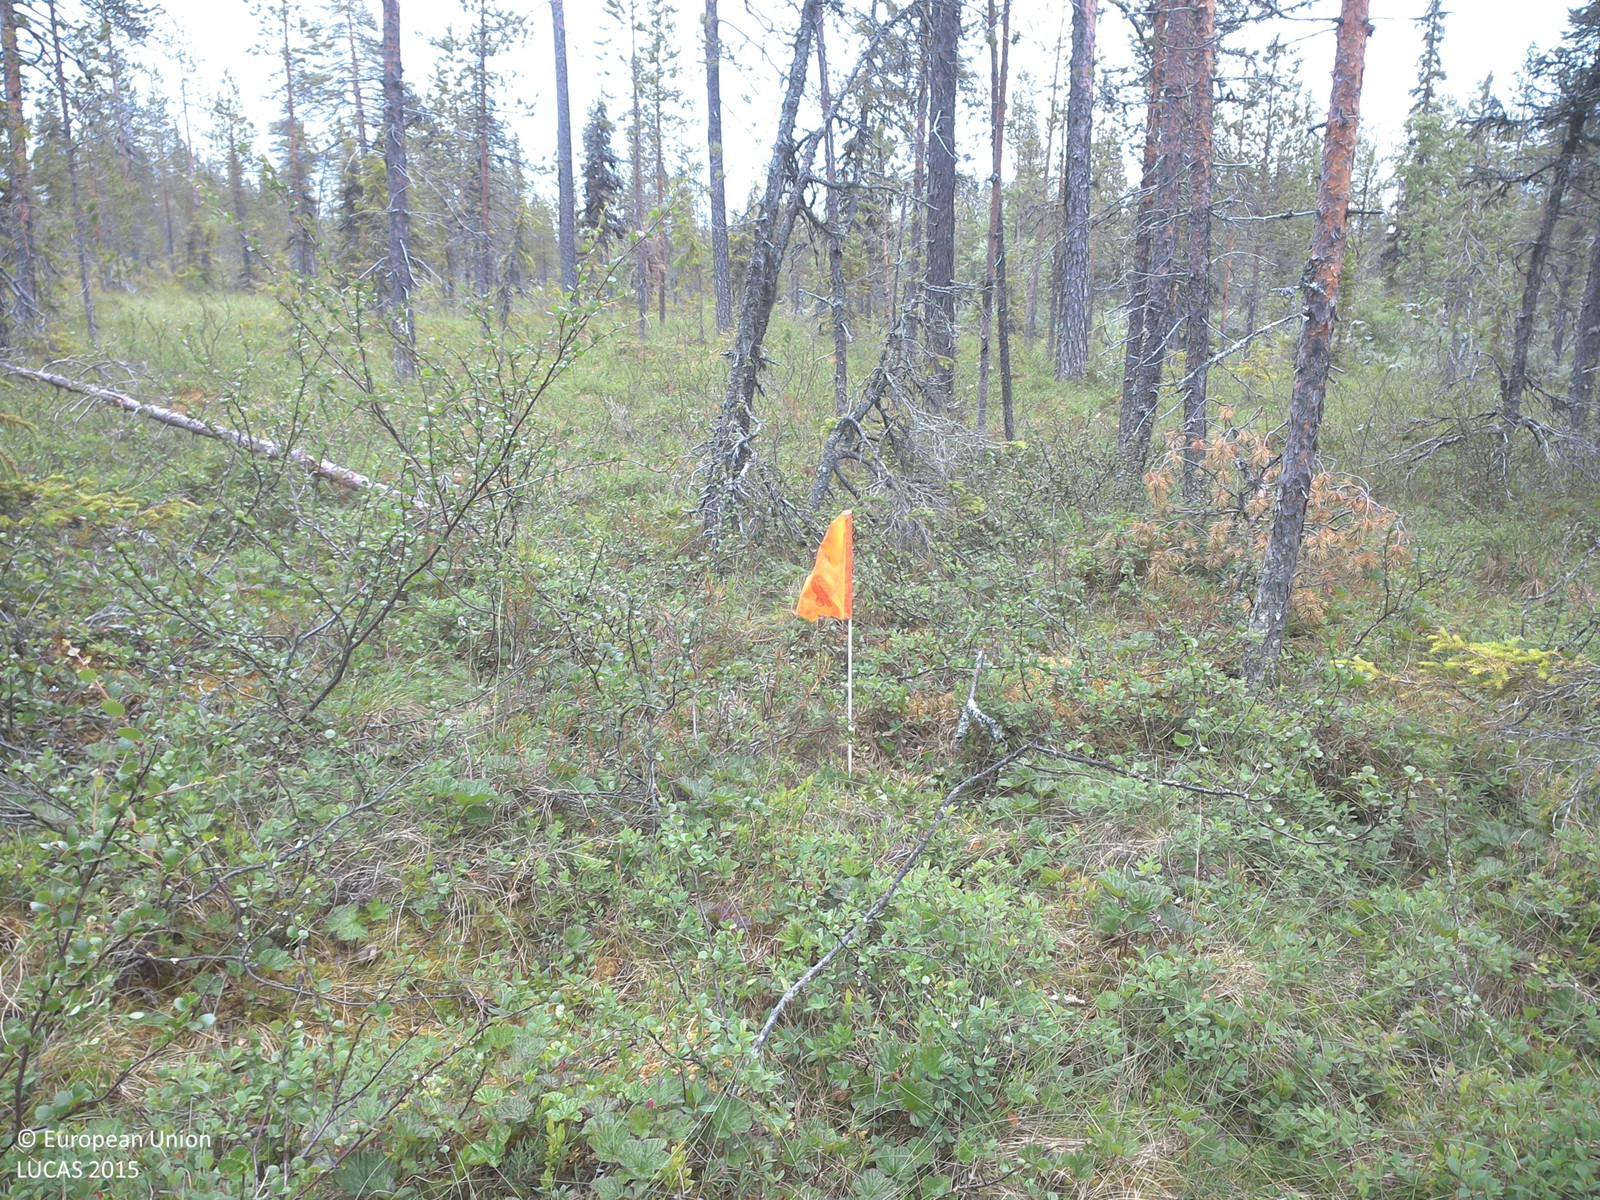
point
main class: Woodland
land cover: Pine dominated coniferous woodland
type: boreal forest
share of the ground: 10 - 25 %
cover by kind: shrubs 40 %, lichens and mosses 30 %, coniferous forest trees 15 %, herbaceous plants 15 %
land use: Semi-natural and natural areas not in use
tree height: > 5 m
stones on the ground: < 10 %
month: July
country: SE
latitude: 67.6180
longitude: 22.9274
